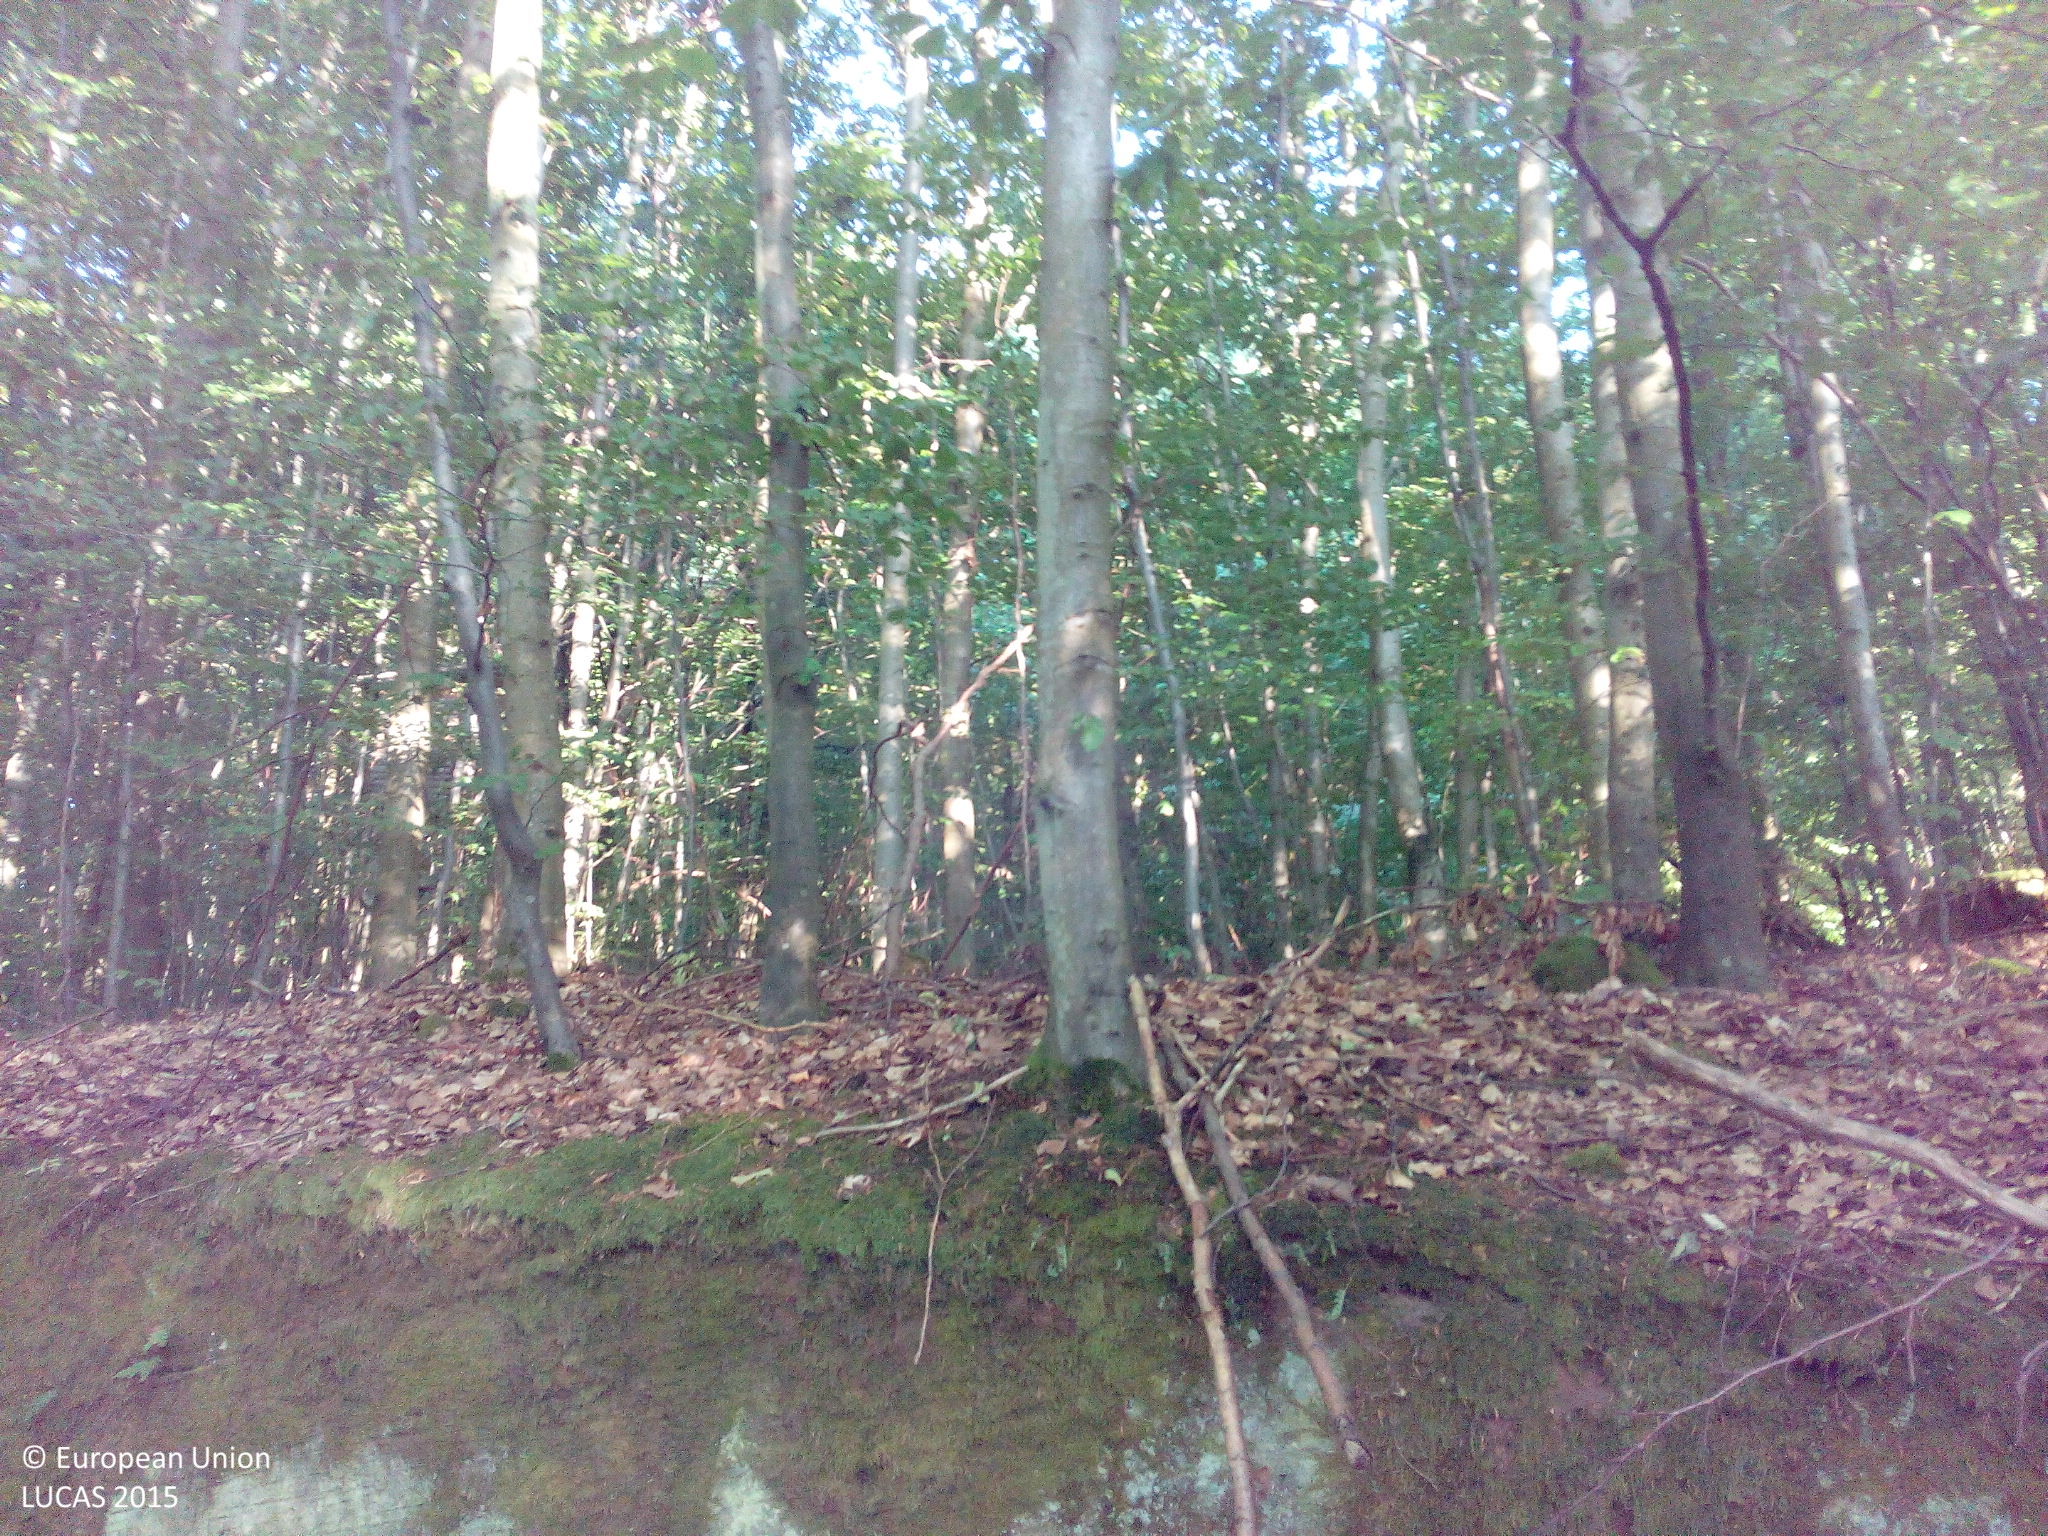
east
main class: Woodland
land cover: Broadleaved woodland
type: beech forest
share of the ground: > 75 %
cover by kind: broadleaved forest trees 90 %, unconsolidated bare surface 10 %
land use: Forestry
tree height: > 5 m
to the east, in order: Broadleaved woodland; Tracks; Broadleaved woodland; Tracks
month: July
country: DE
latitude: 49.1514
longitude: 7.6012
